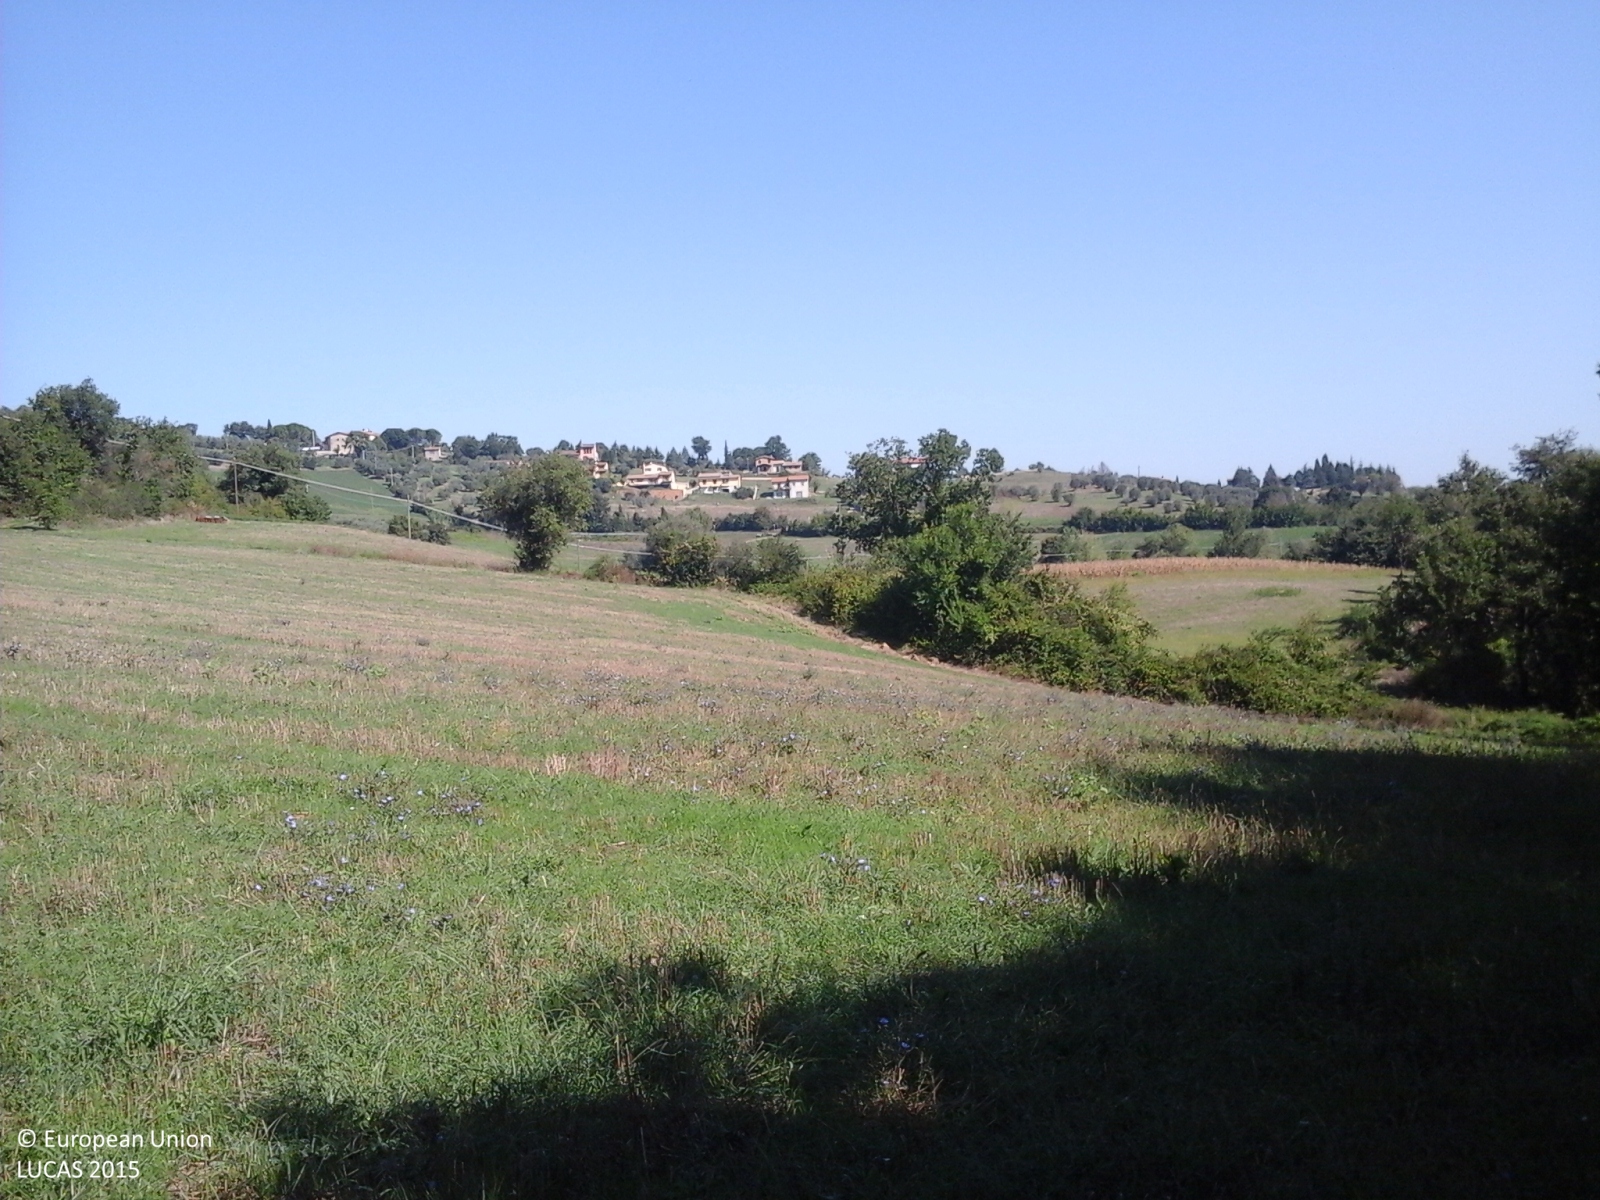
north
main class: Woodland
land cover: Broadleaved woodland
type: thermophilous deciduous forest
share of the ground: > 75 %
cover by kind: broadleaved forest trees 100 %
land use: Forestry
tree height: > 5 m
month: August
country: IT
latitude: 42.8987
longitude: 12.3076
